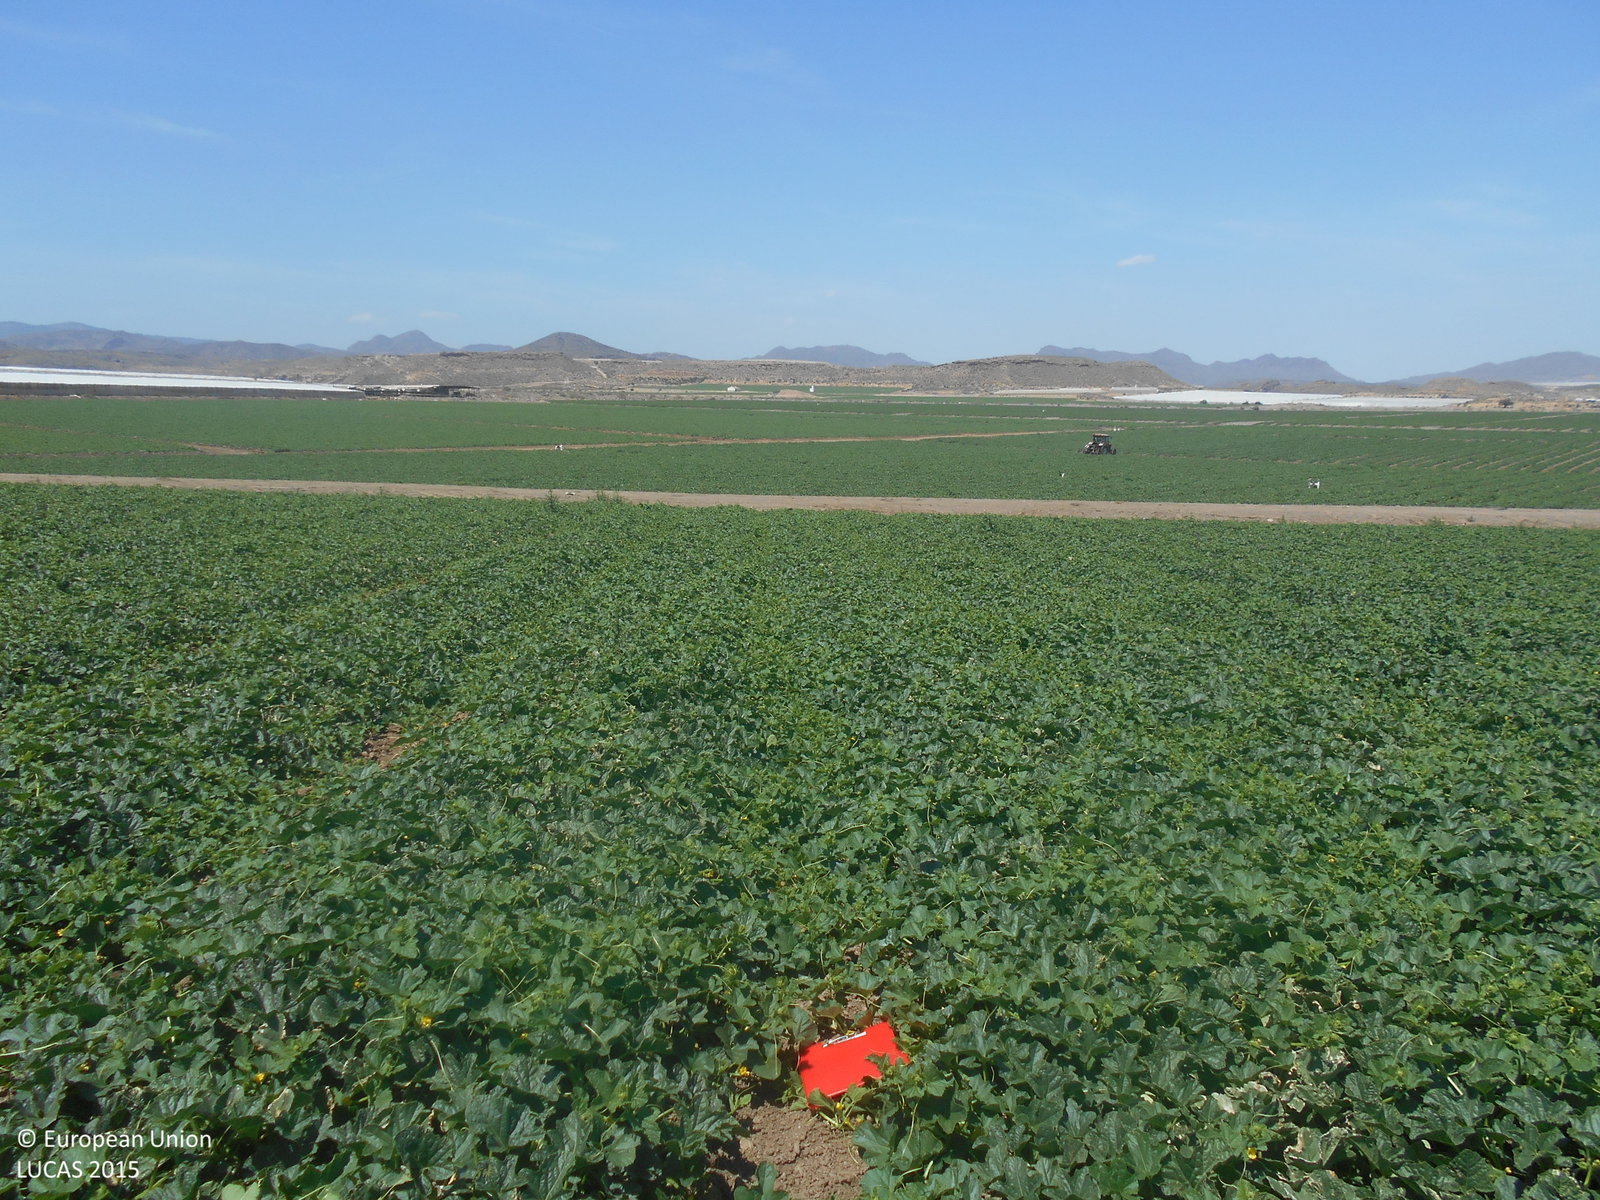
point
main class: Cropland
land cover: Other fresh vegetables
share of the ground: > 75 %
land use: Agriculture (excluding fallow land and kitchen gardens)
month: May
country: ES
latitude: 37.5150
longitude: -1.4174
